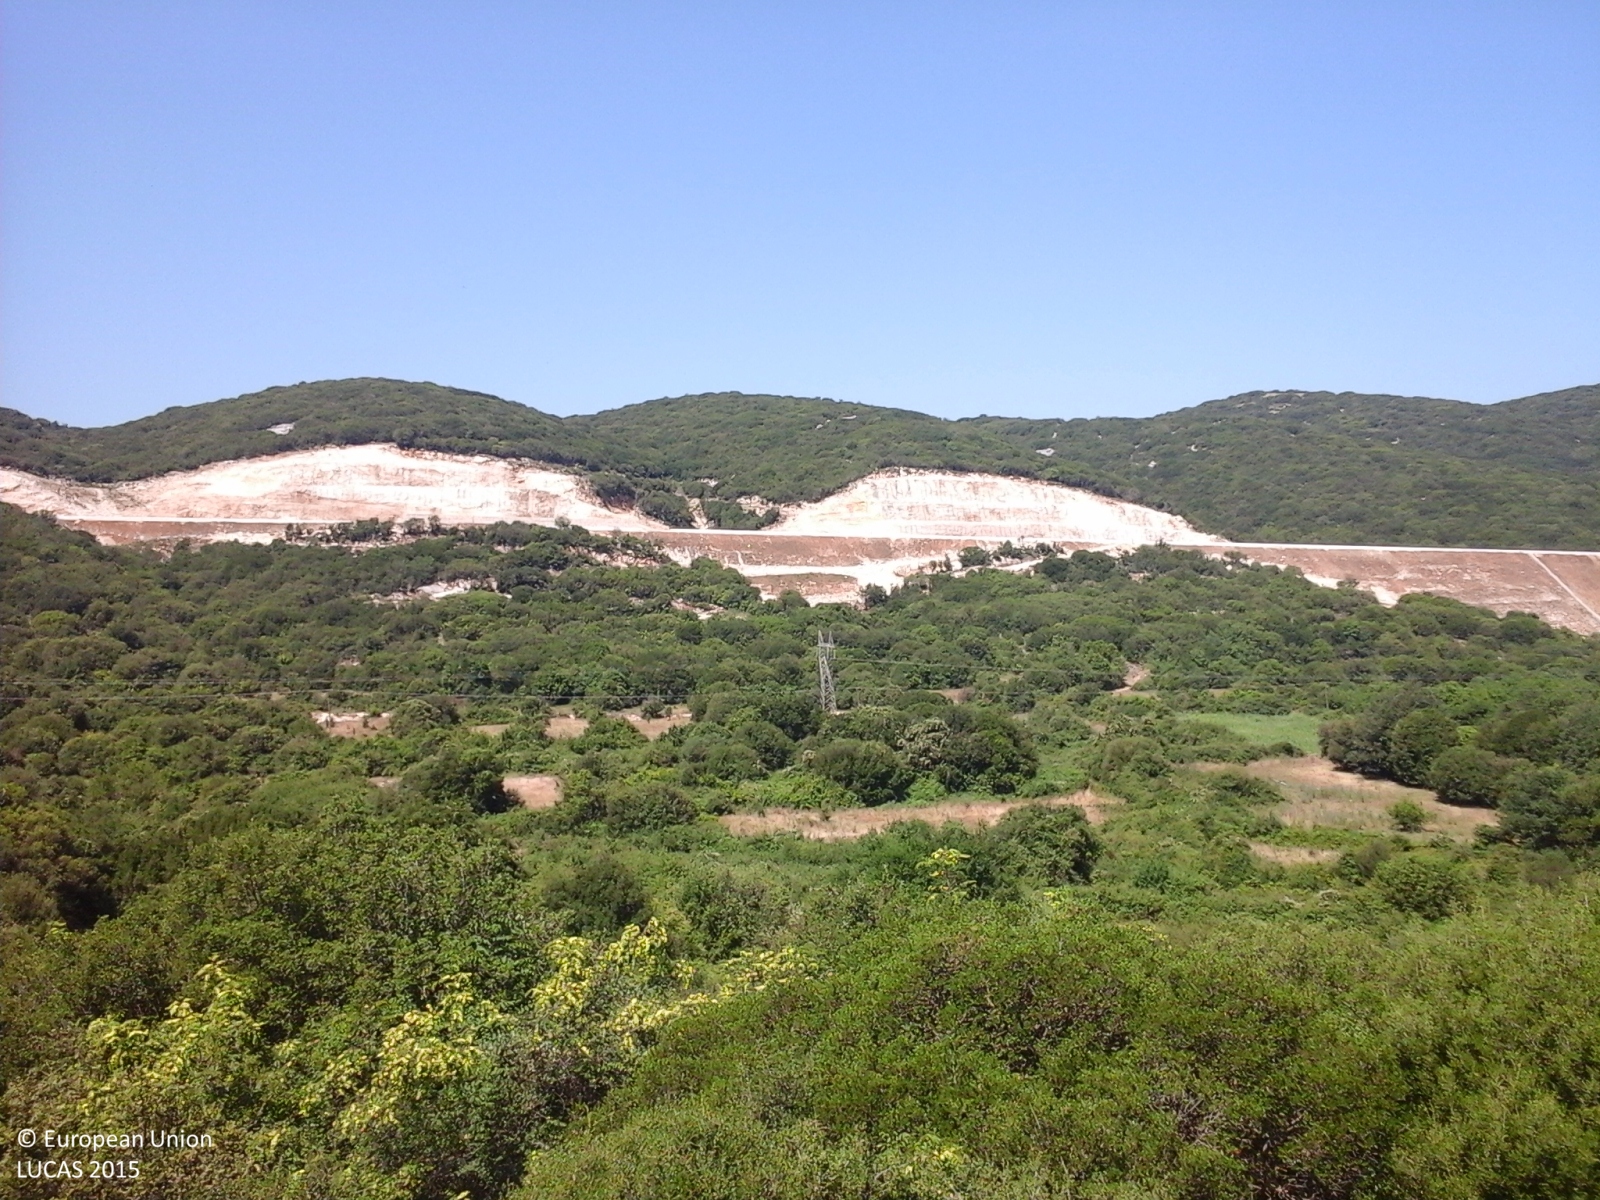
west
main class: Shrubland
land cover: Shrubland with sparse tree cover
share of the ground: > 75 %
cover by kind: shrubs 90 %, broadleaved forest trees 5 %, unconsolidated bare surface 5 %
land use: Semi-natural and natural areas not in use
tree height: < 5 m
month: July
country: GR
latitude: 39.4023
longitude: 20.9035
